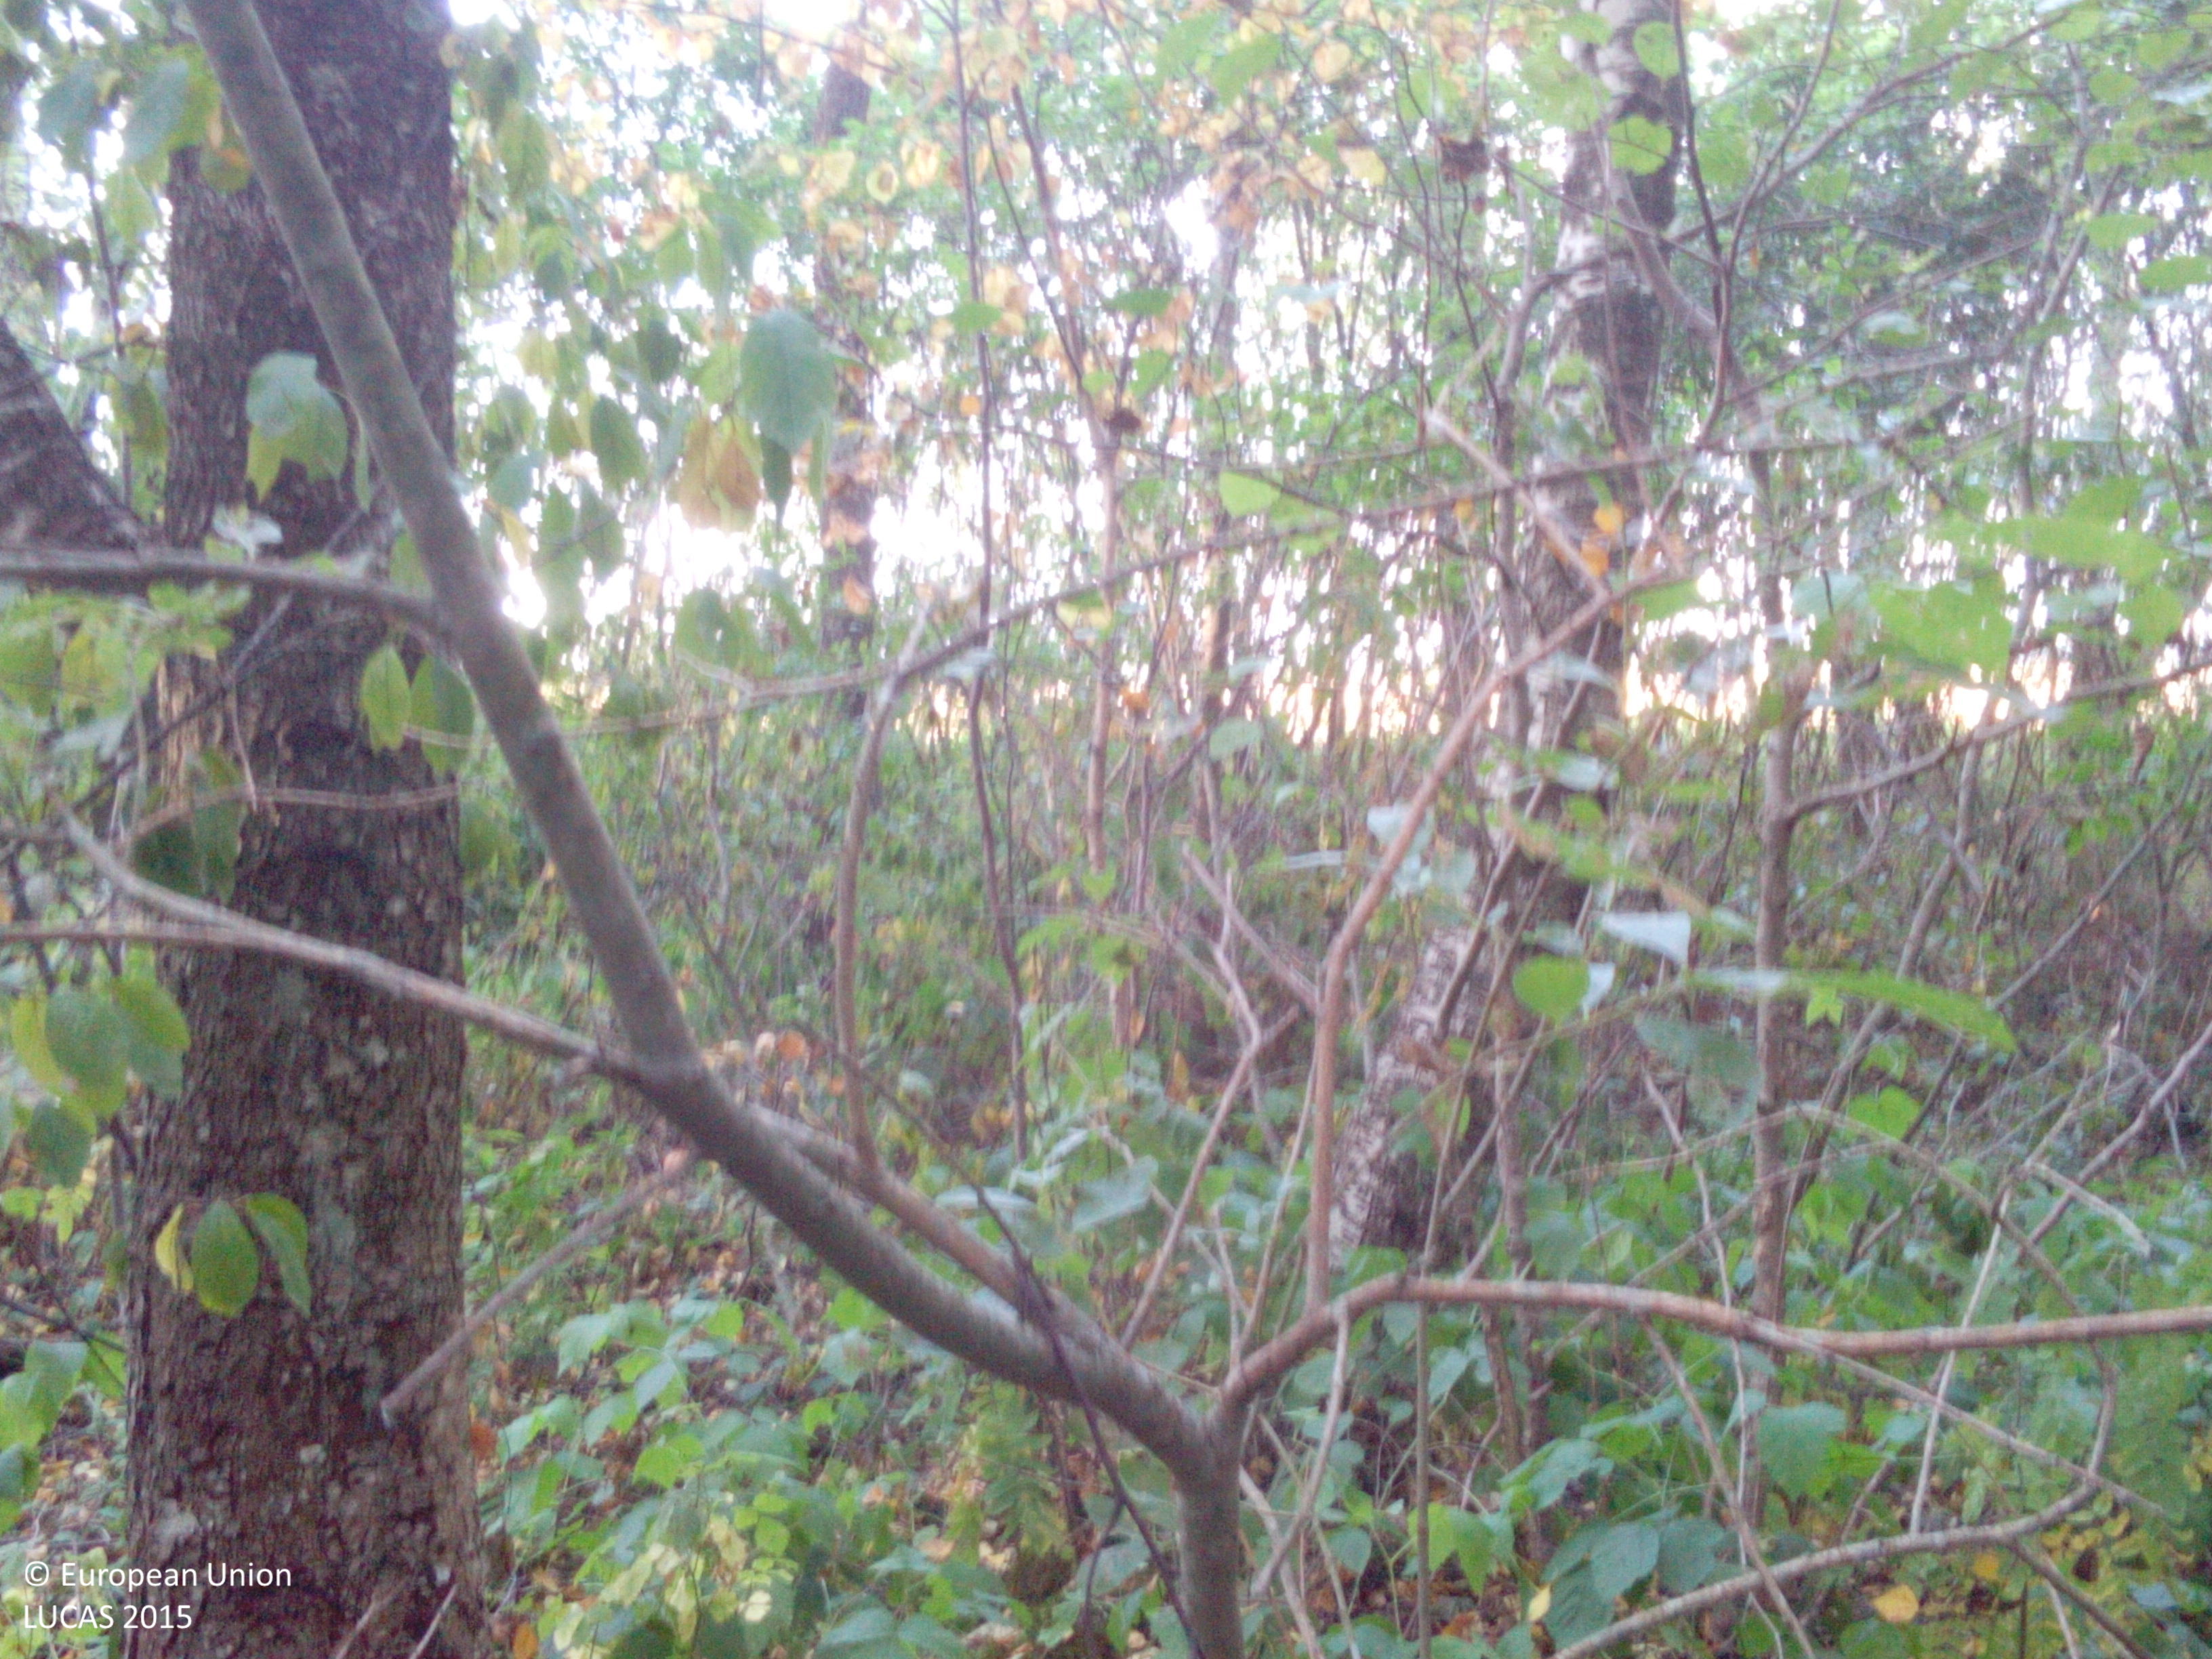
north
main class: Woodland
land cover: Broadleaved woodland
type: non-riverine alder, birch or aspen forest
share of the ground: > 75 %
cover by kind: broadleaved forest trees 85 %, herbaceous plants 10 %, shrubs 5 %
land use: Forestry
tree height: > 5 m
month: August
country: LV
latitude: 56.4507
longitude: 21.0857
